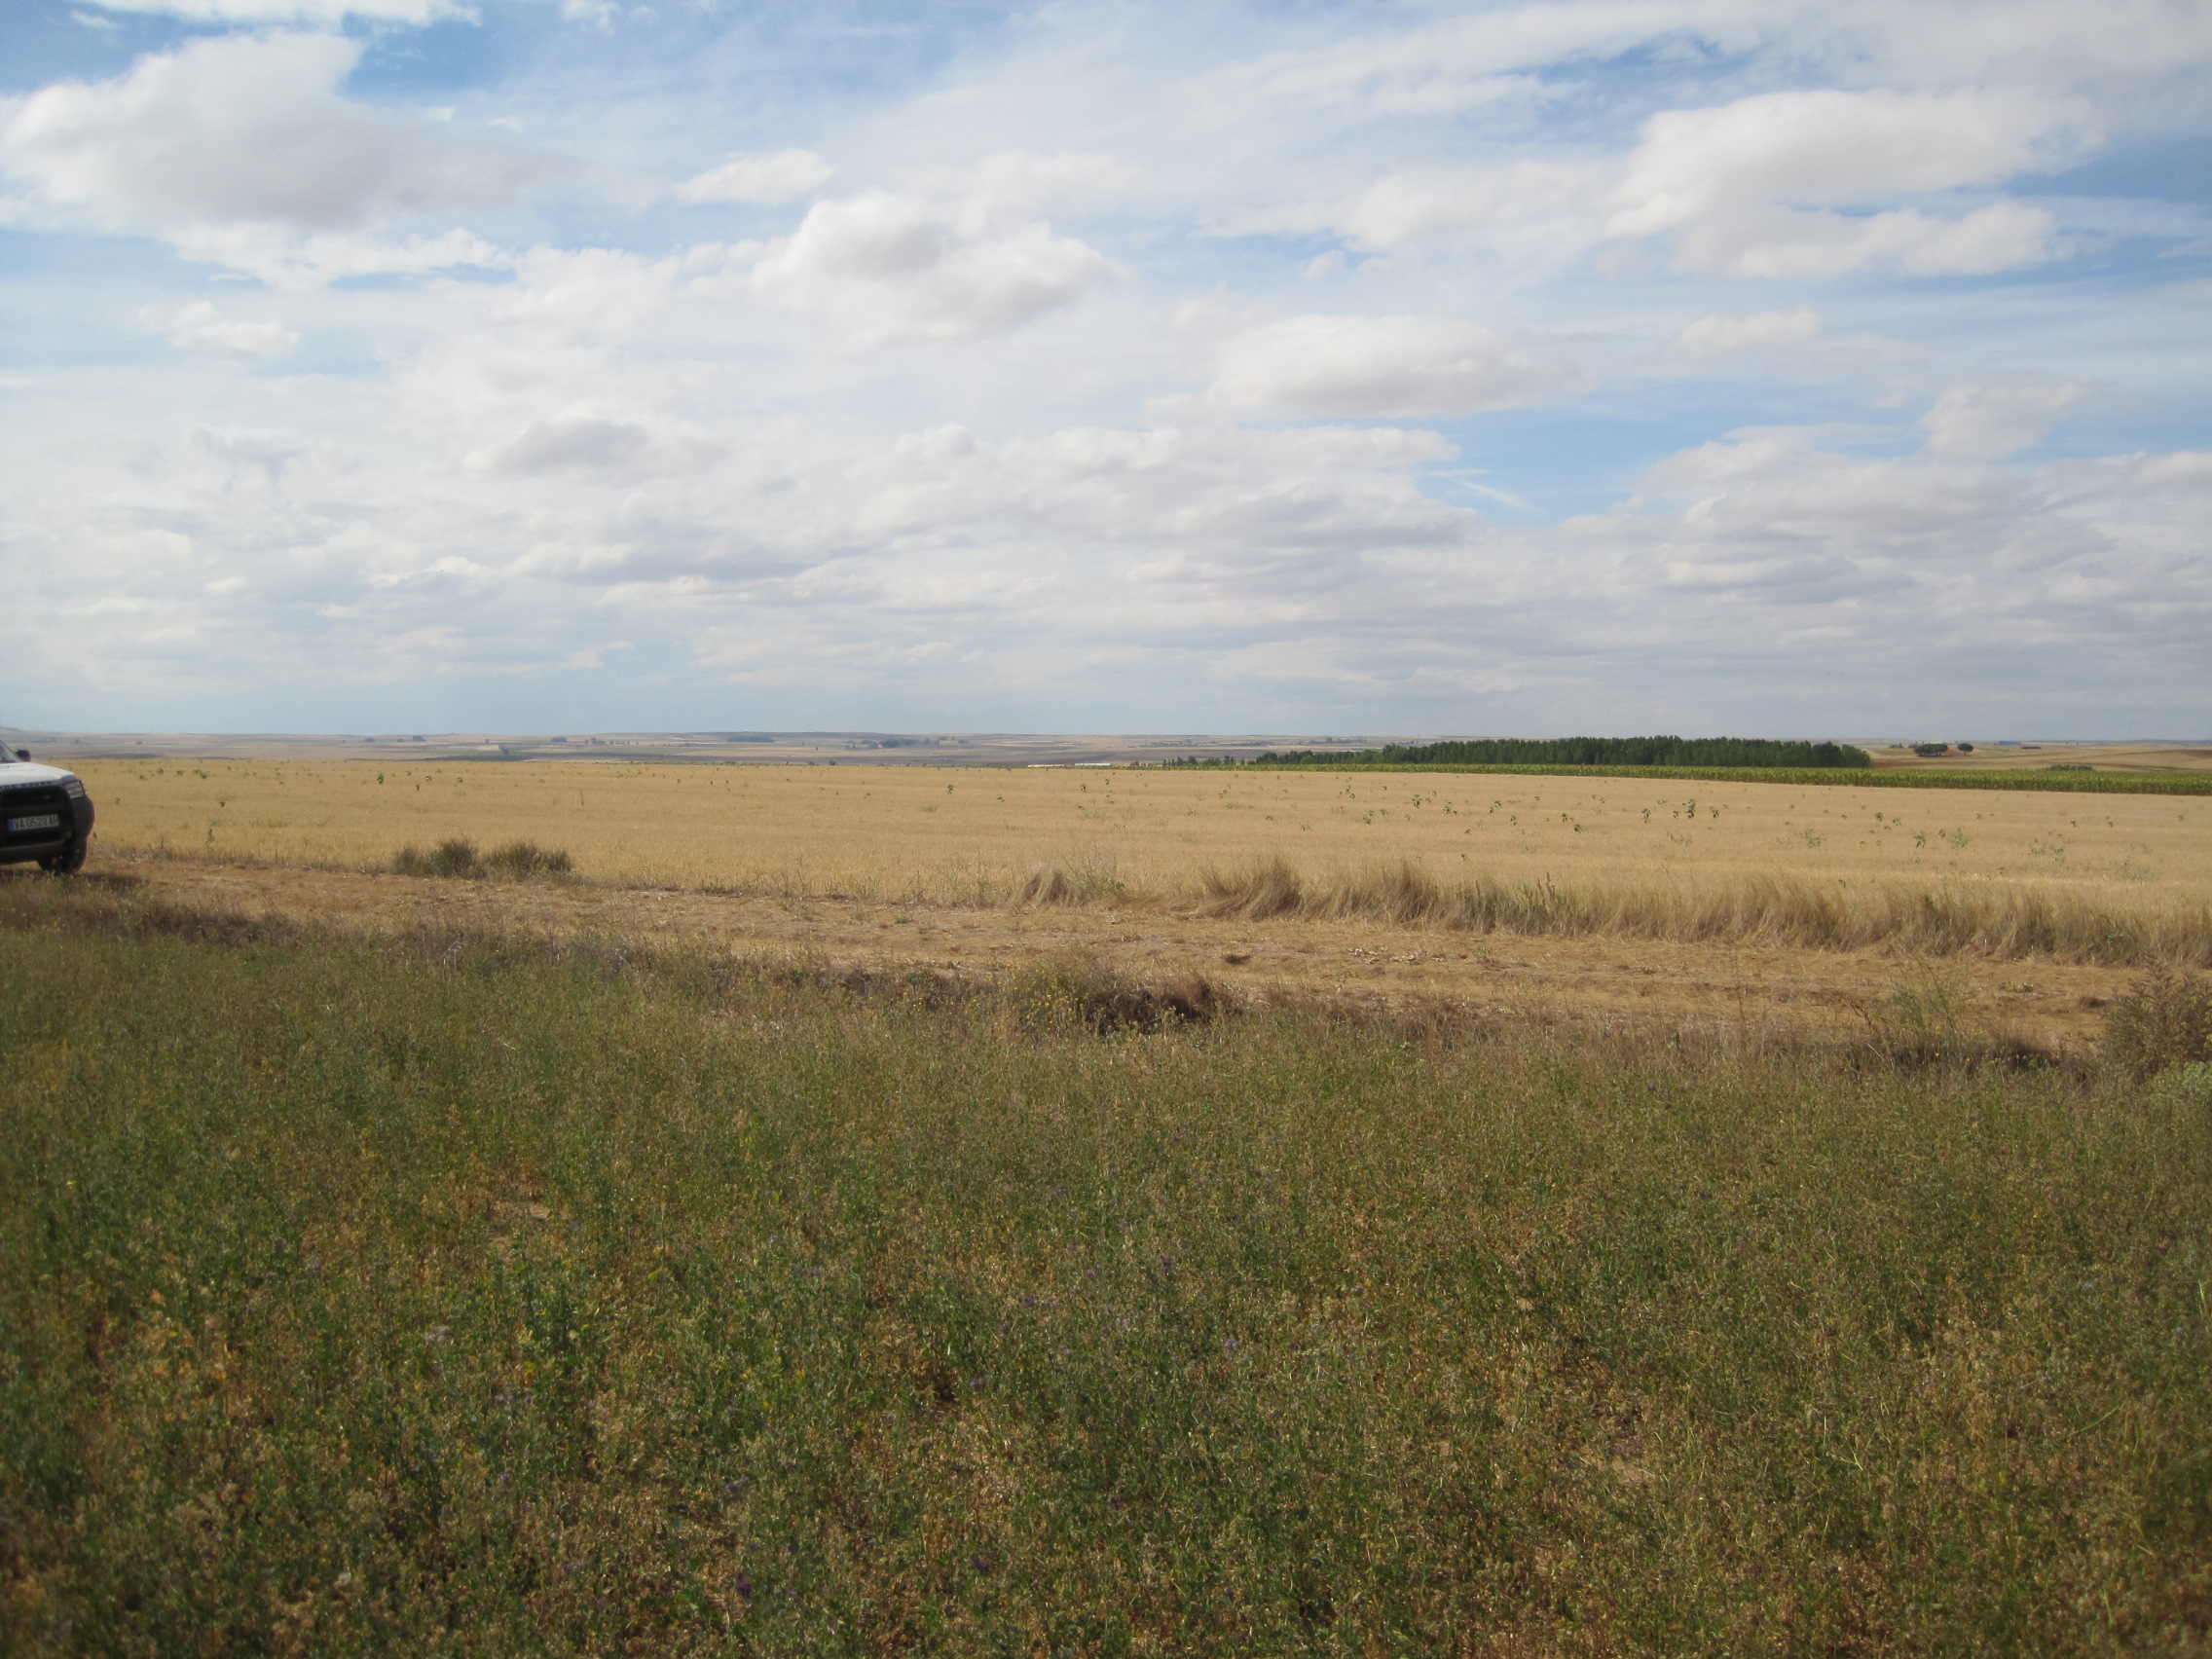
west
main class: Cropland
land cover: Lucerne
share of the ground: > 75 %
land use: Agriculture (excluding fallow land and kitchen gardens)
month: July
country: ES
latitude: 41.9860
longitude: -5.2553
